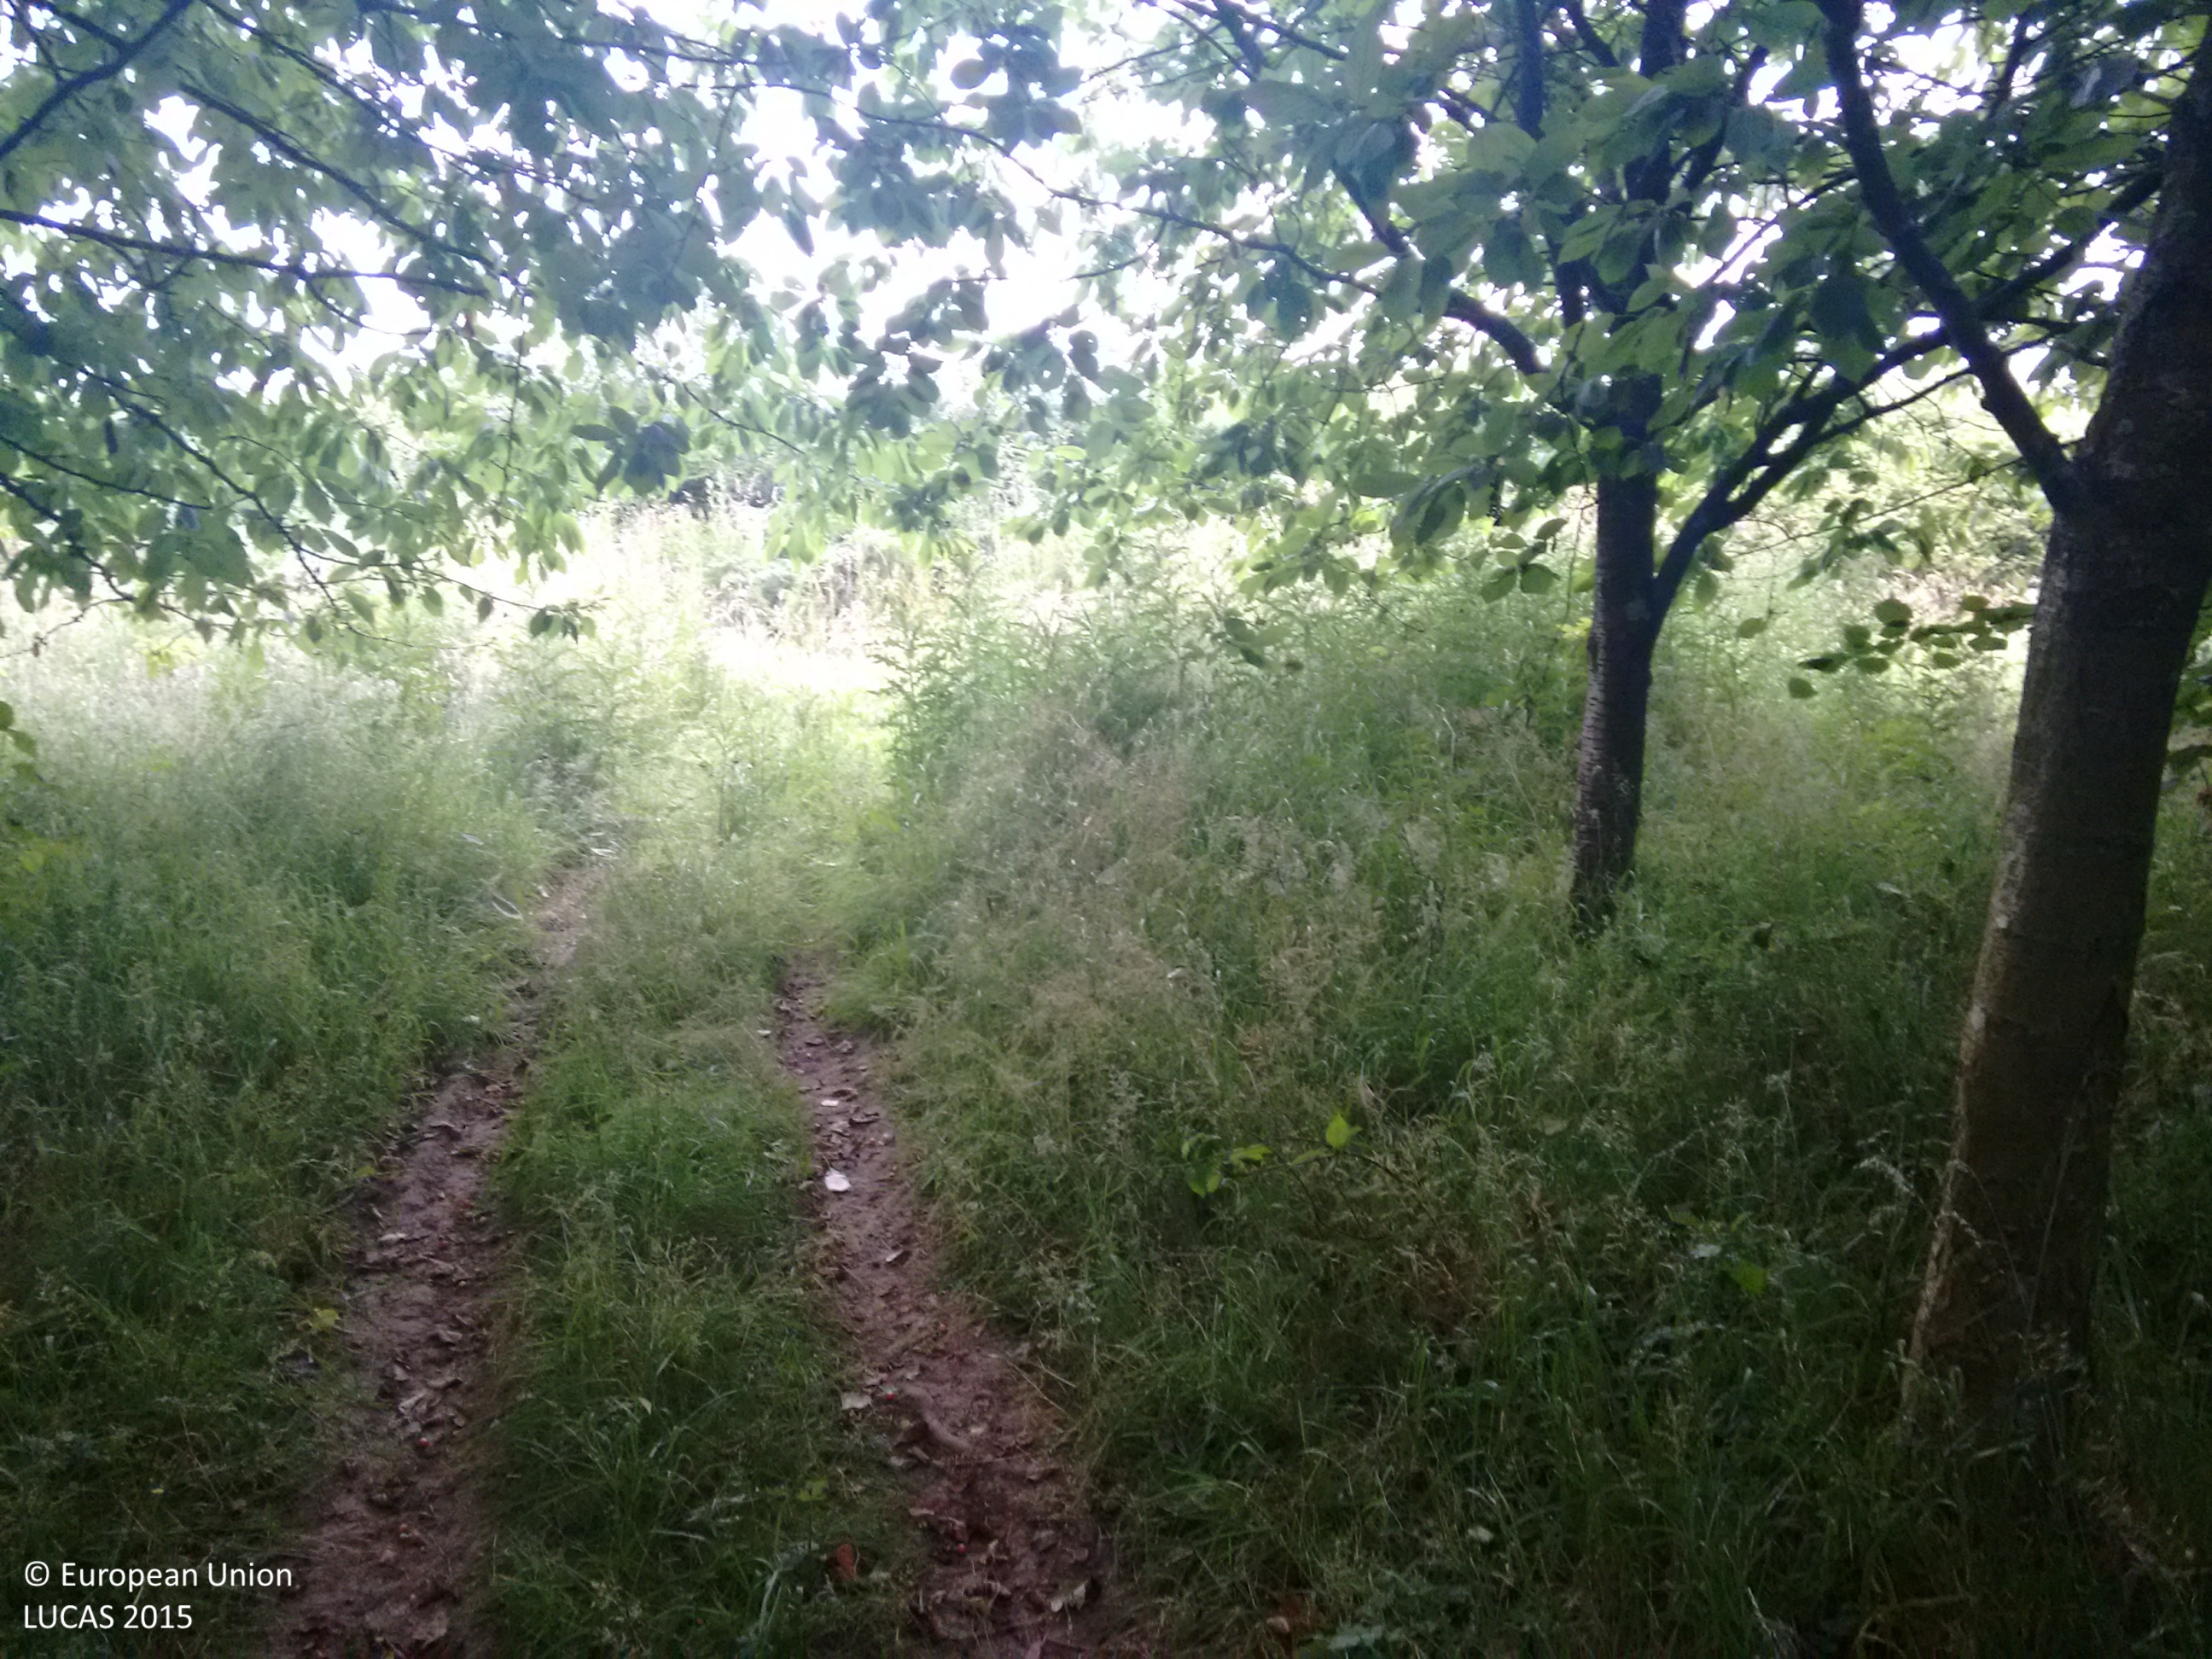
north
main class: Woodland
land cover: Broadleaved woodland
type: mesophytic deciduous forest
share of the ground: > 75 %
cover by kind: broadleaved forest trees 100 %
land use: Forestry
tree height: > 5 m
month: July
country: GB
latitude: 50.9099
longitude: -0.9233
